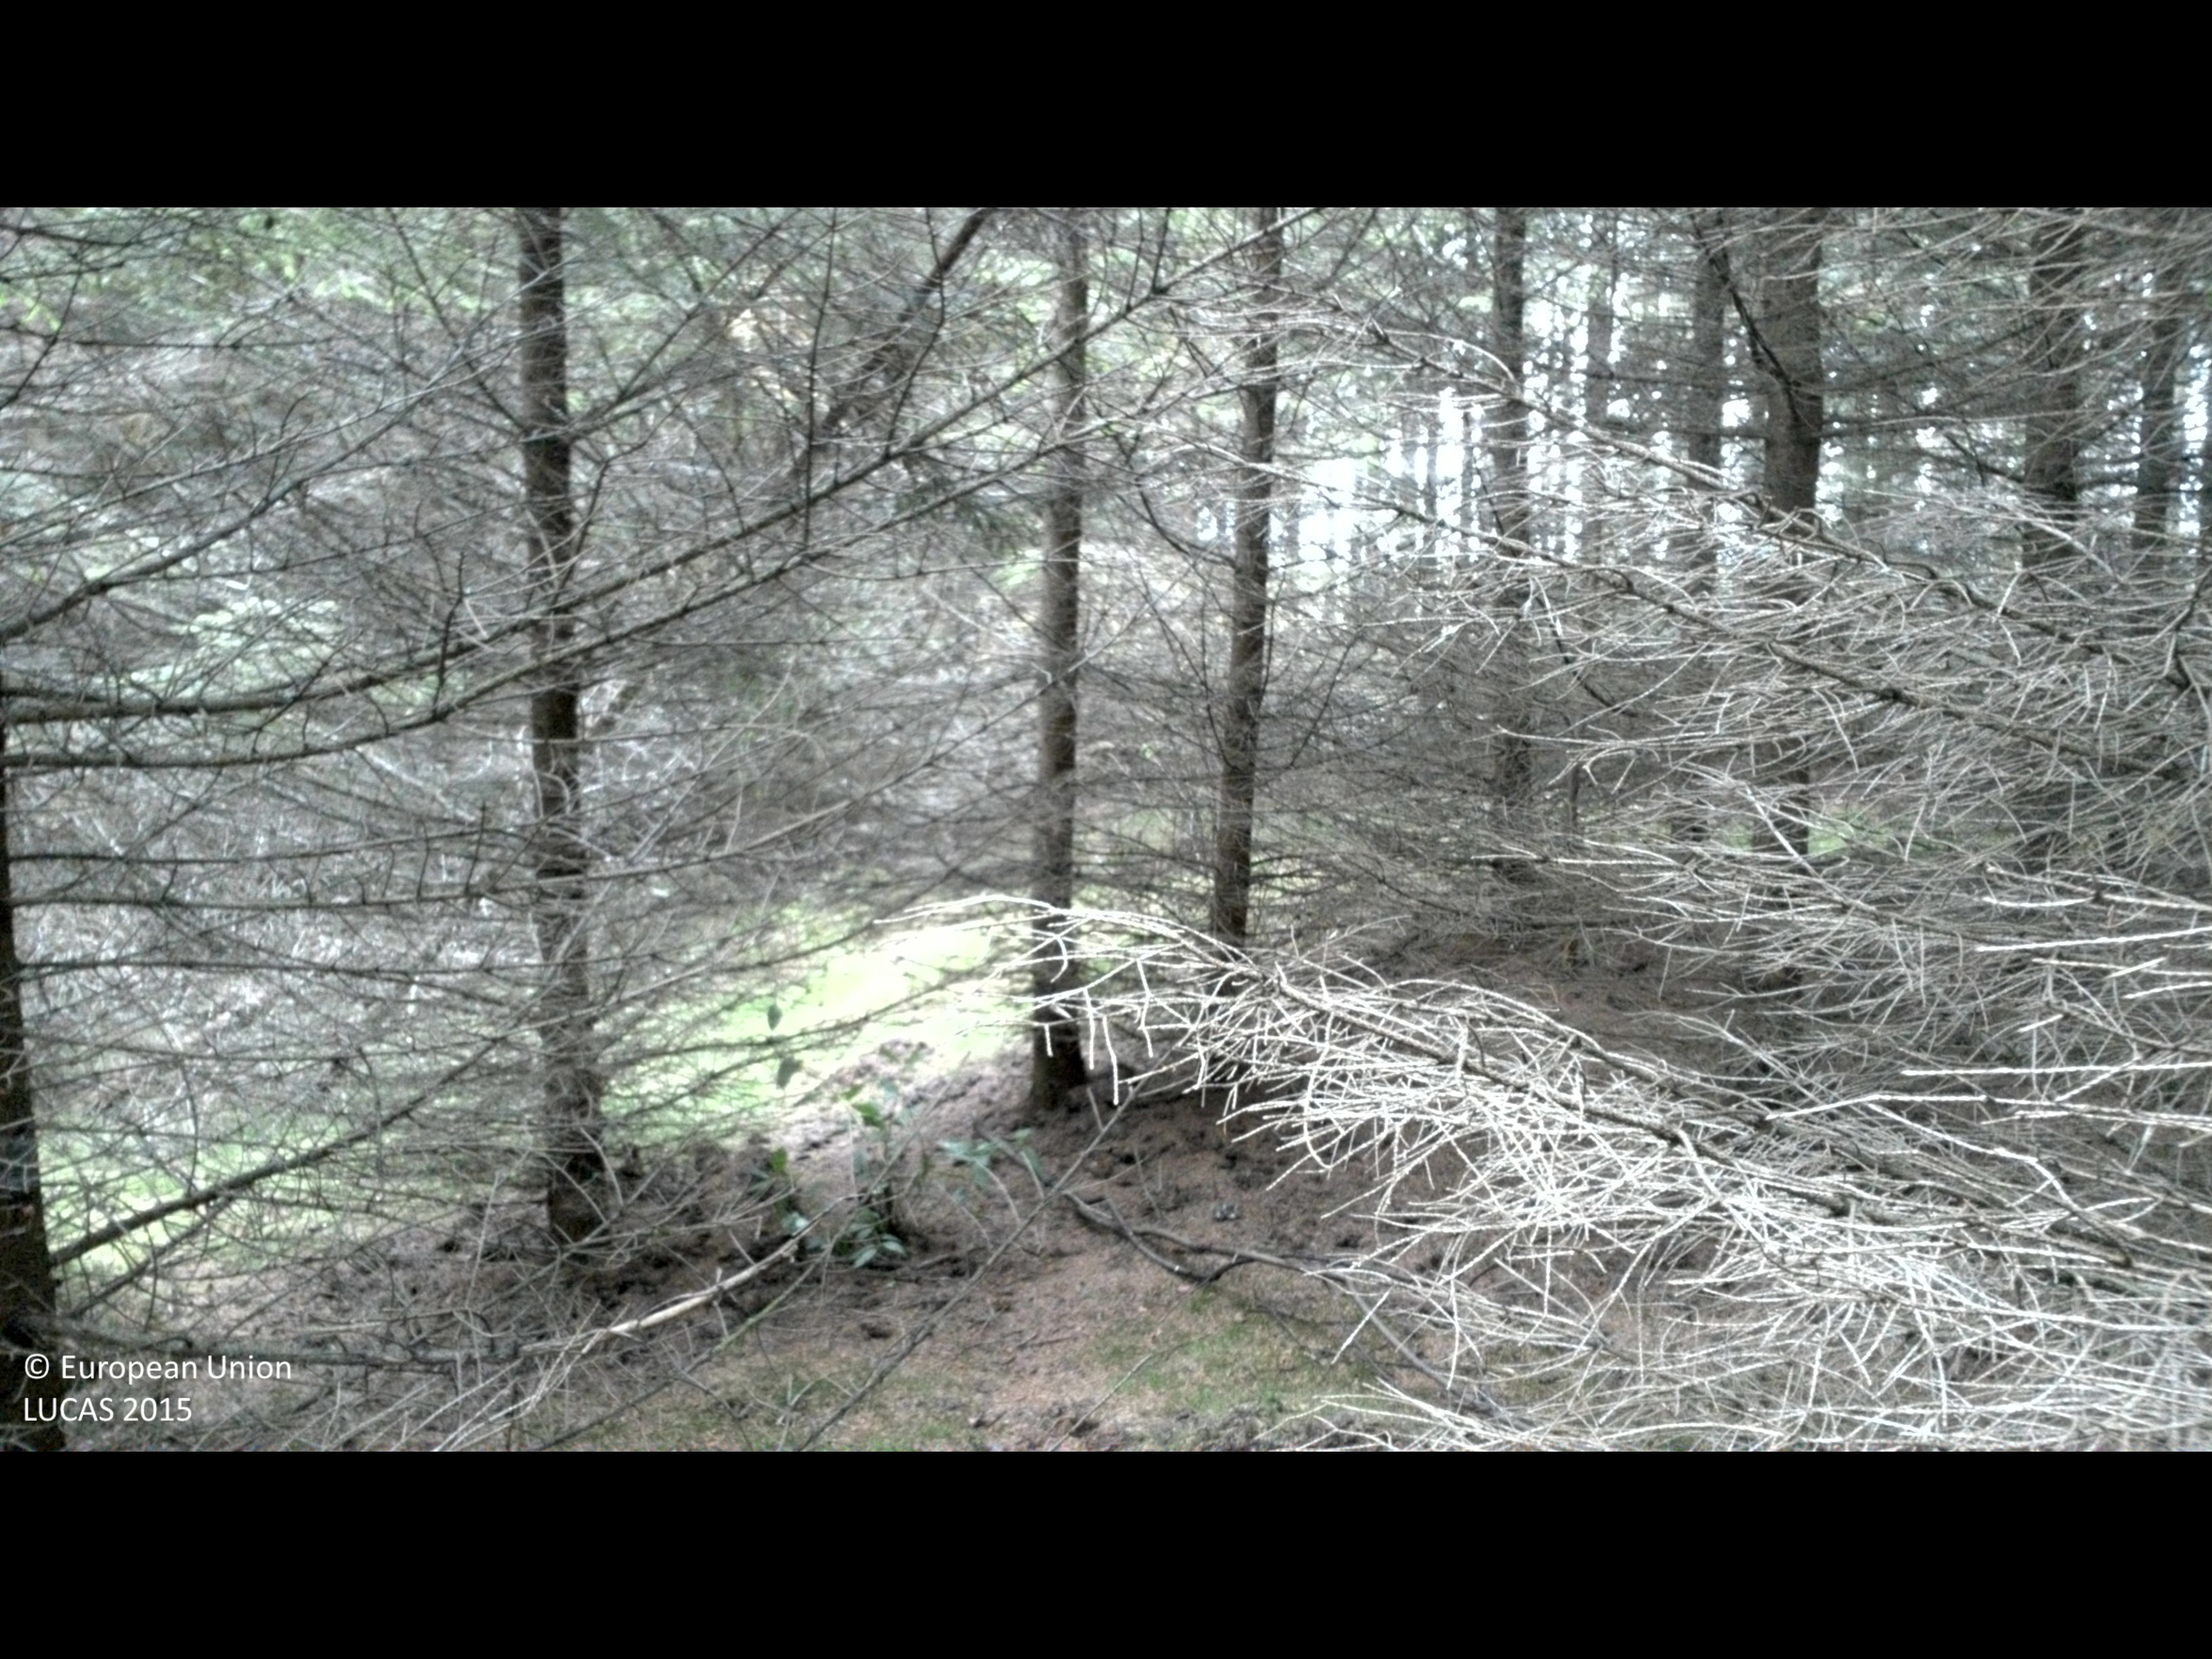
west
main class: Woodland
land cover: Spruce dominated coniferous woodland
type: boreal forest
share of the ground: > 75 %
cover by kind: coniferous forest trees 90 %, lichens and mosses 5 %
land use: Forestry
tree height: > 5 m
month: September
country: SE
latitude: 56.1372
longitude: 14.1978
